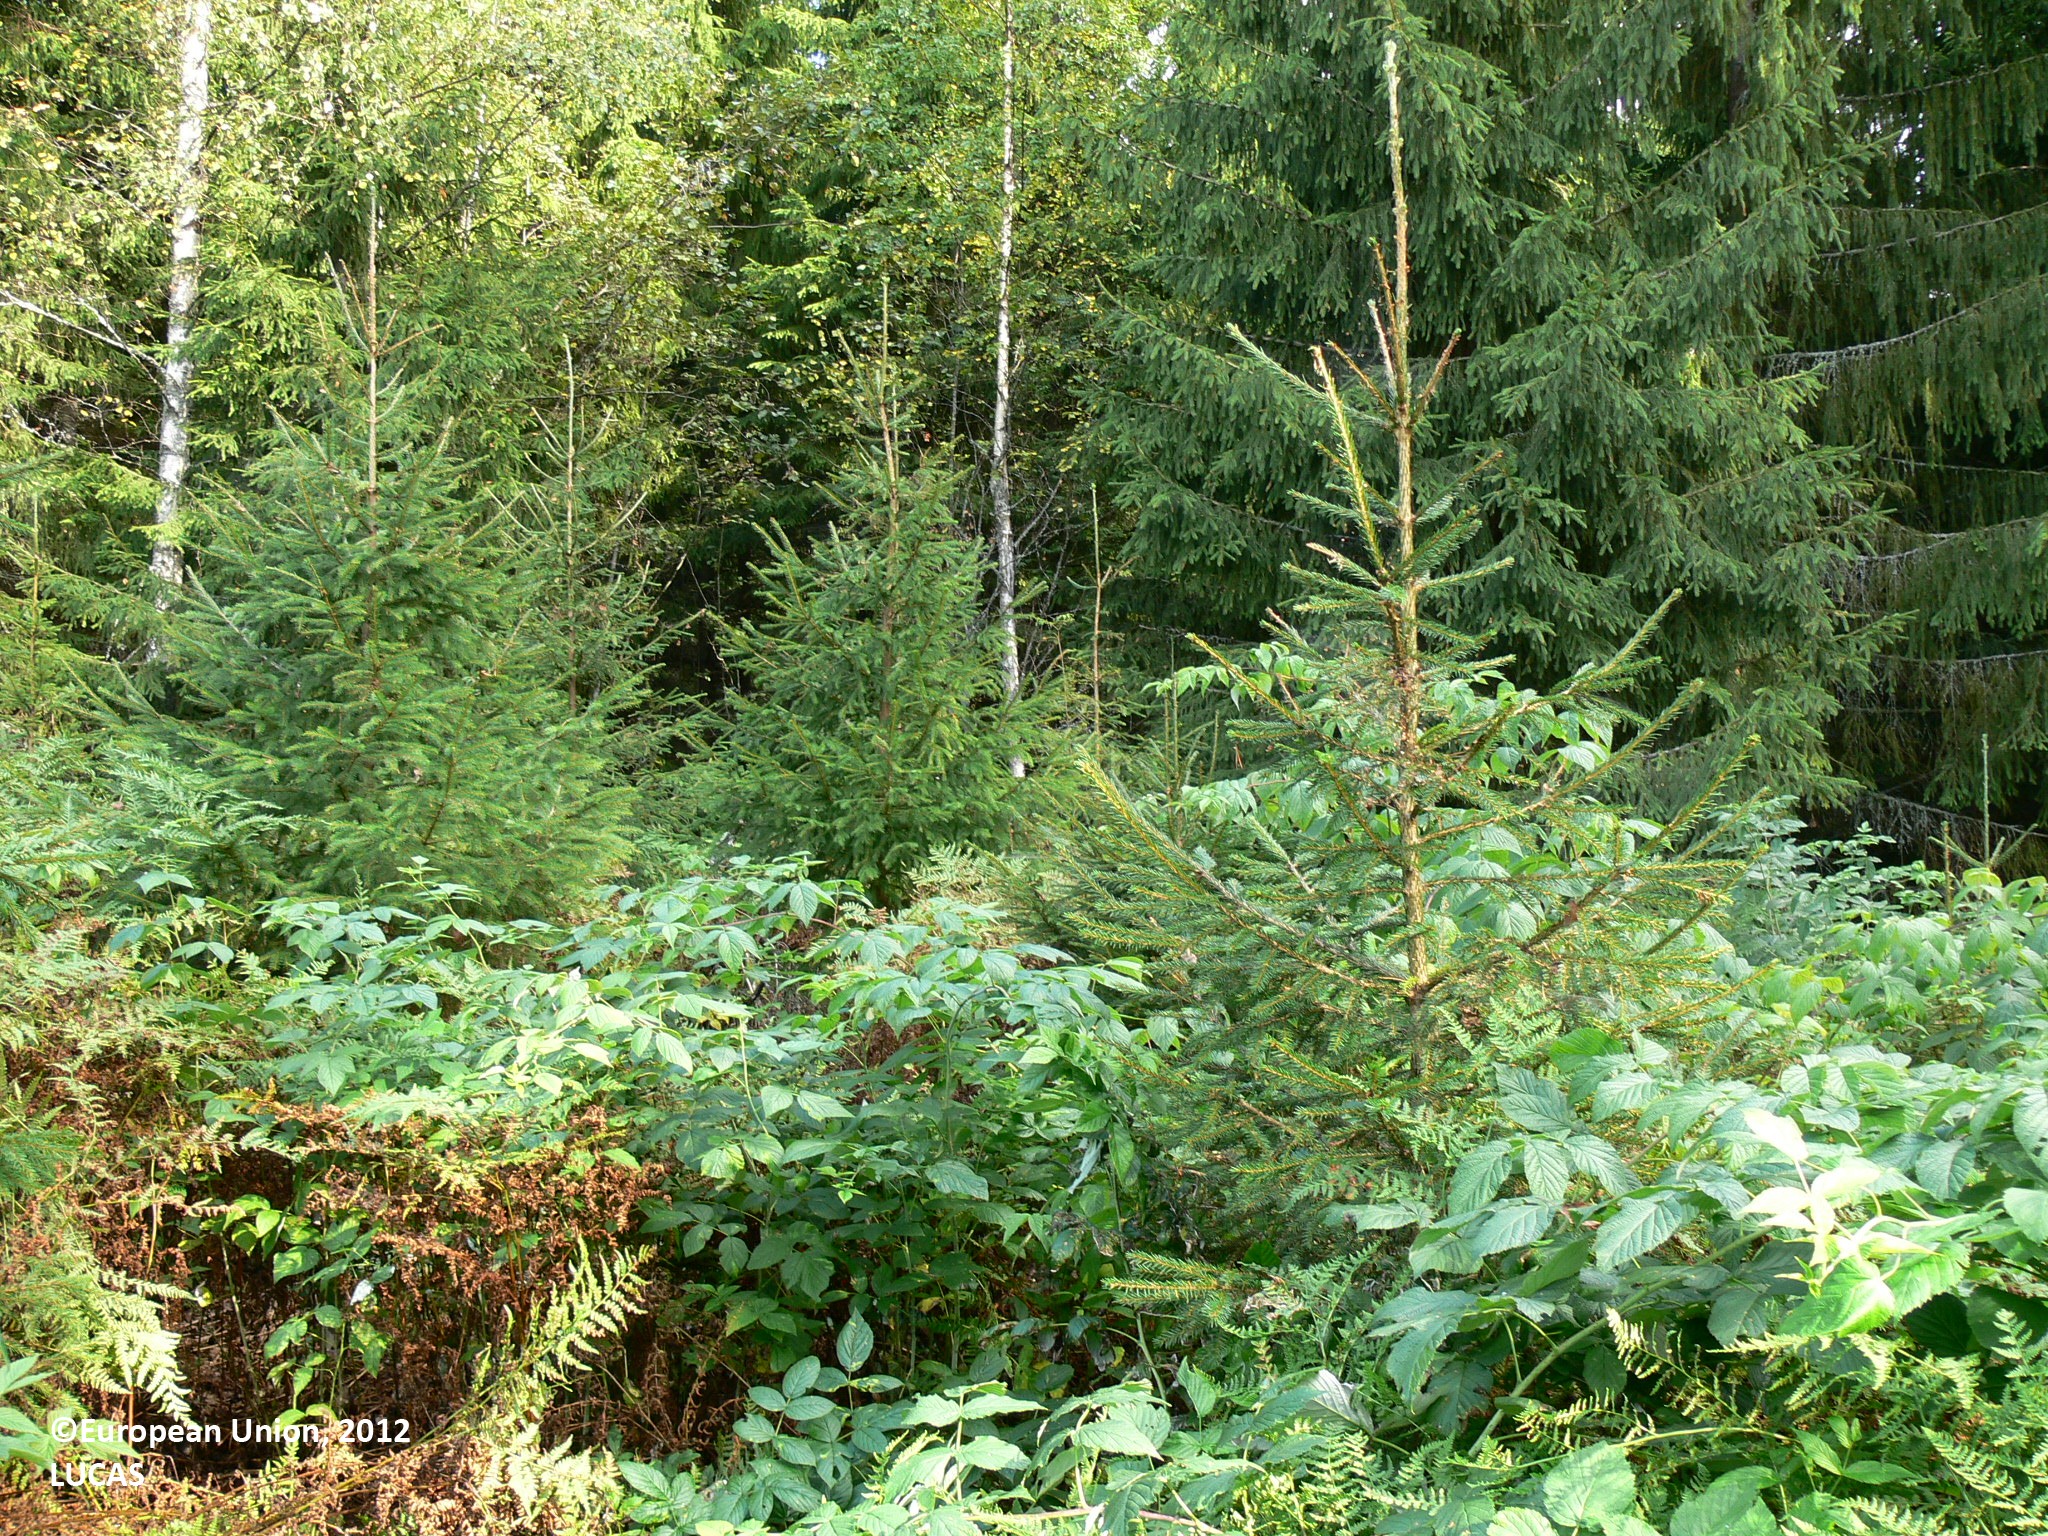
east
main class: Woodland
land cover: Spruce dominated coniferous woodland
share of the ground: 10 - 25 %
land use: Forestry
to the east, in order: Spruce dominated coniferous woodland; Spruce dominated mixed woodland; Ditches and canals; Rye; Grass margins; Spruce dominated mixed woodland
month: August
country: FI
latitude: 62.0469
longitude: 30.3008
